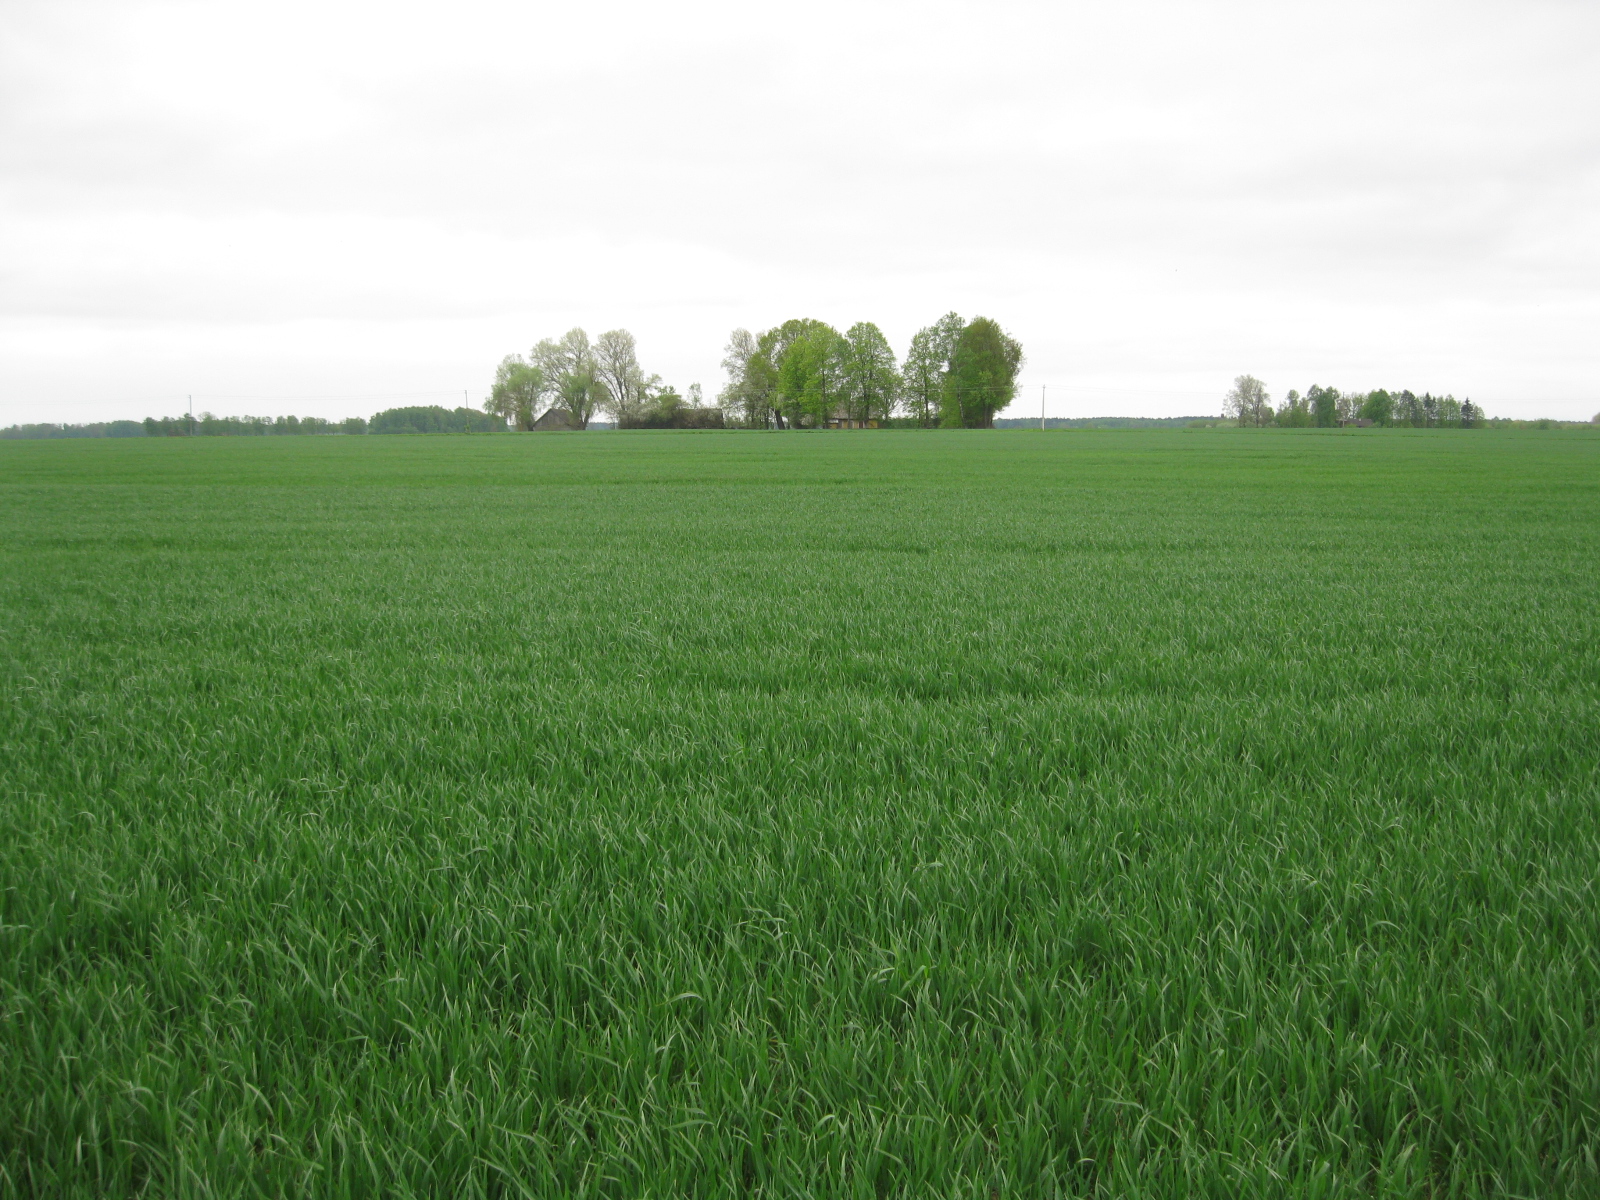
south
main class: Cropland
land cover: Common wheat
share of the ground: > 75 %
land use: Agriculture (excluding fallow land and kitchen gardens)
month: May
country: LT
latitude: 55.9939
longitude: 24.3802
